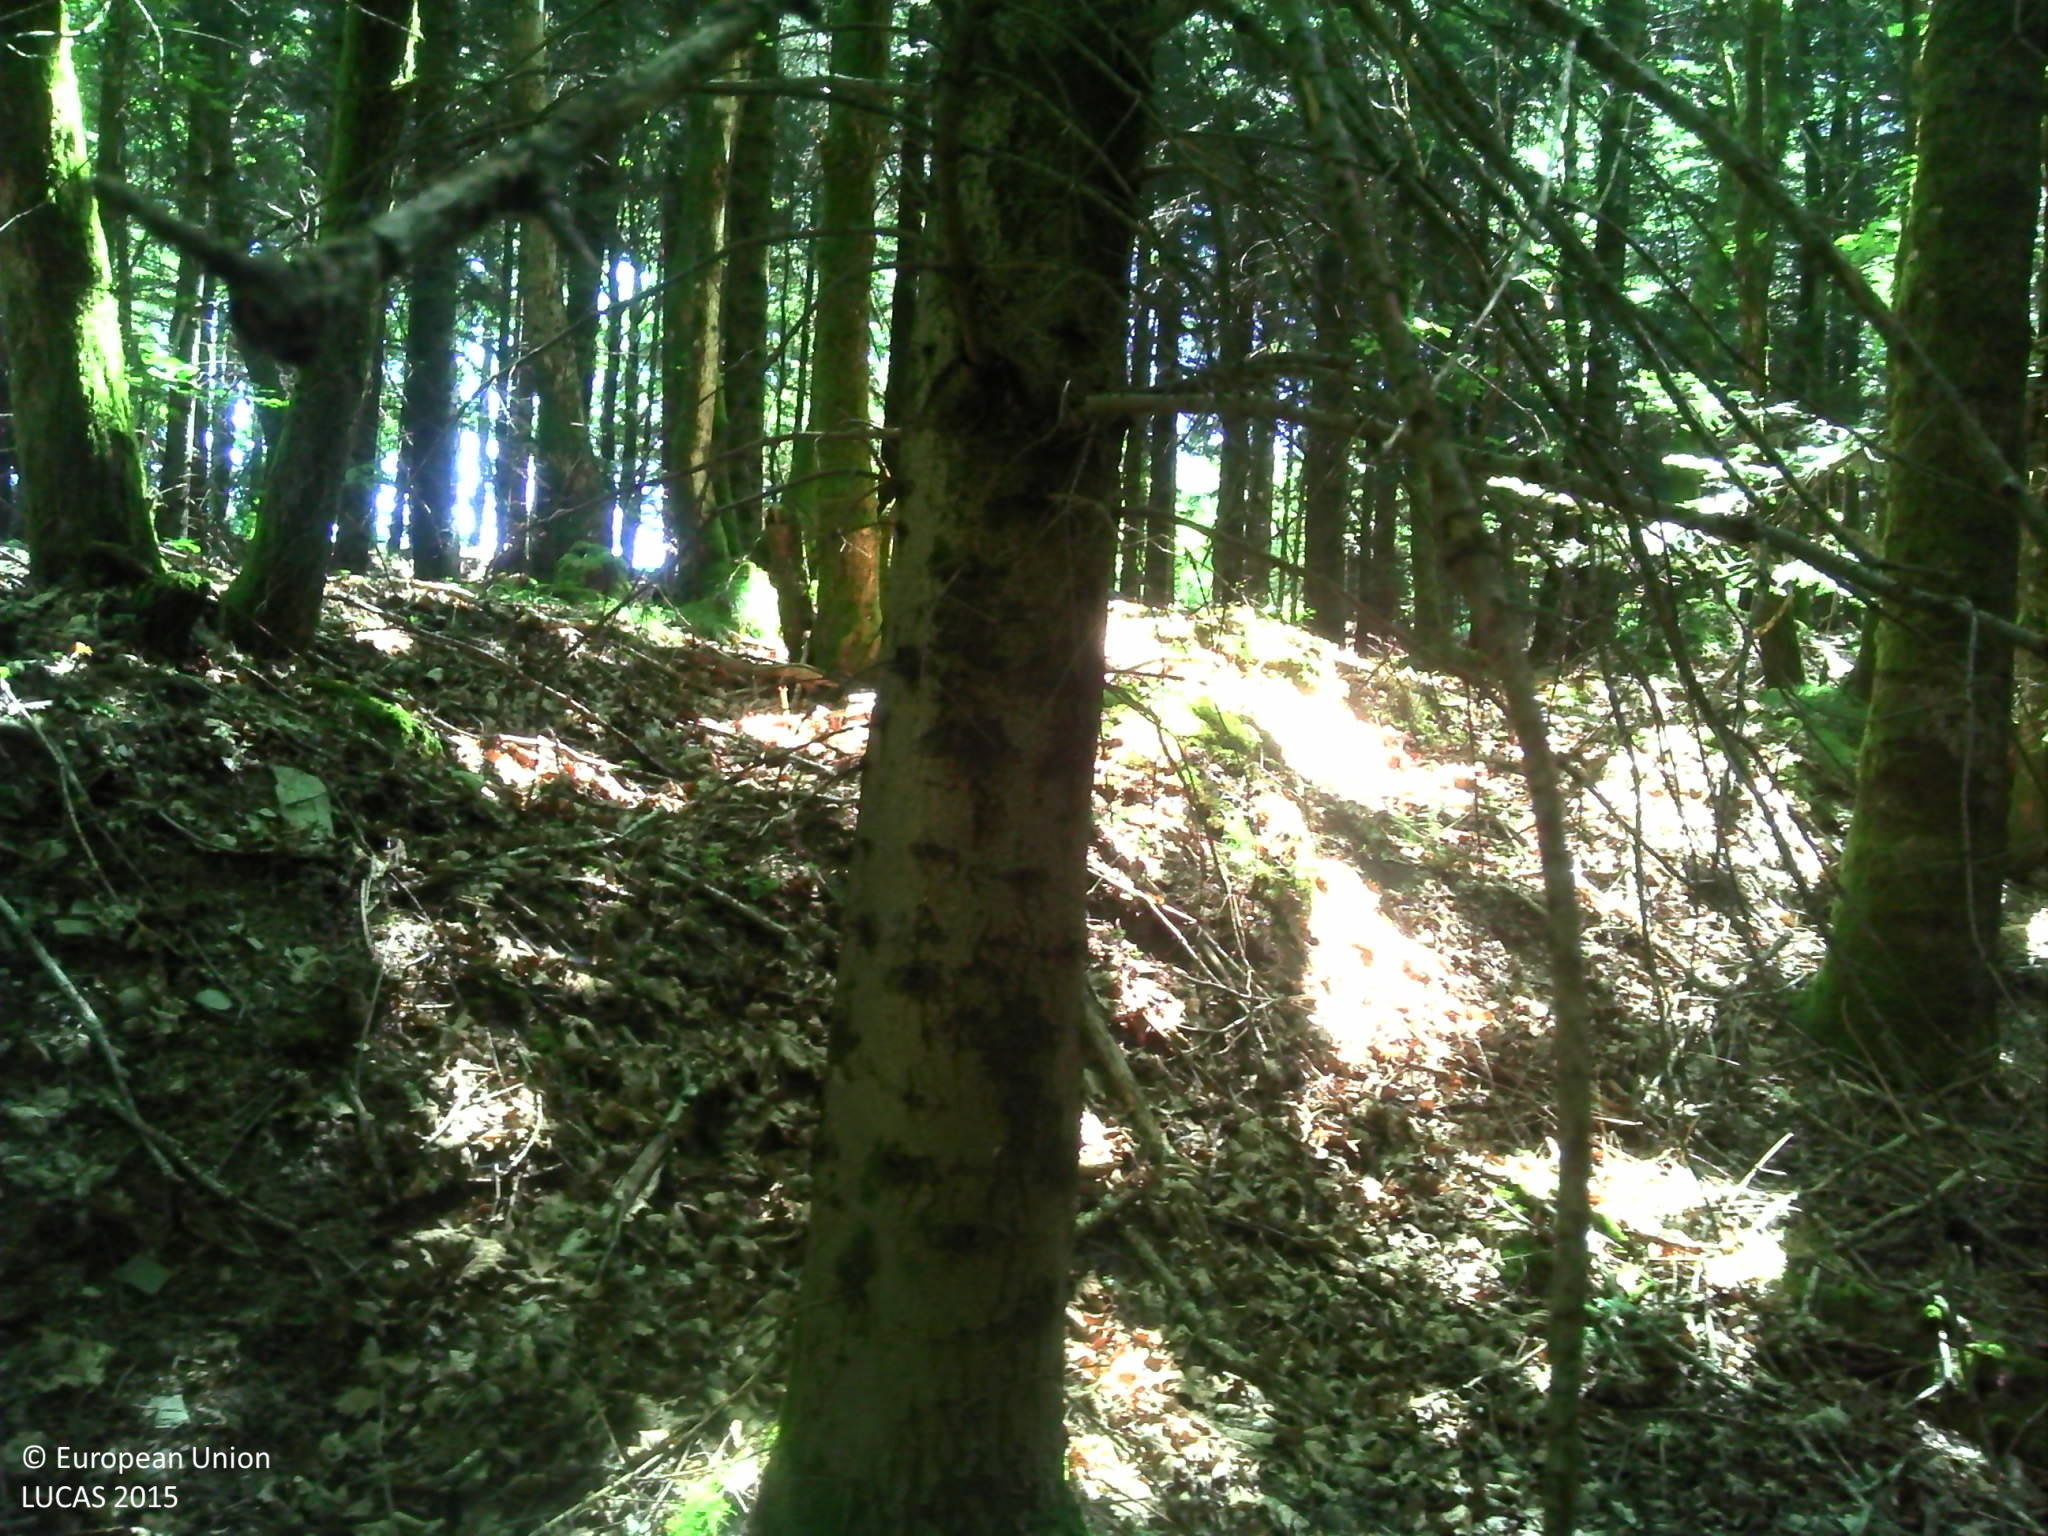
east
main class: Woodland
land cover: Spruce dominated coniferous woodland
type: exotic forest
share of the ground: > 75 %
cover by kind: coniferous forest trees 100 %
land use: Forestry
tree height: > 5 m
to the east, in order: Spruce dominated coniferous woodland; Tracks; Ditches and canals; Spruce dominated mixed woodland; Common wheat; Grass margins; Broadleaved woodland; Spruce dominated coniferous woodland
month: June
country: FR
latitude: 43.7577
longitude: 2.5662
